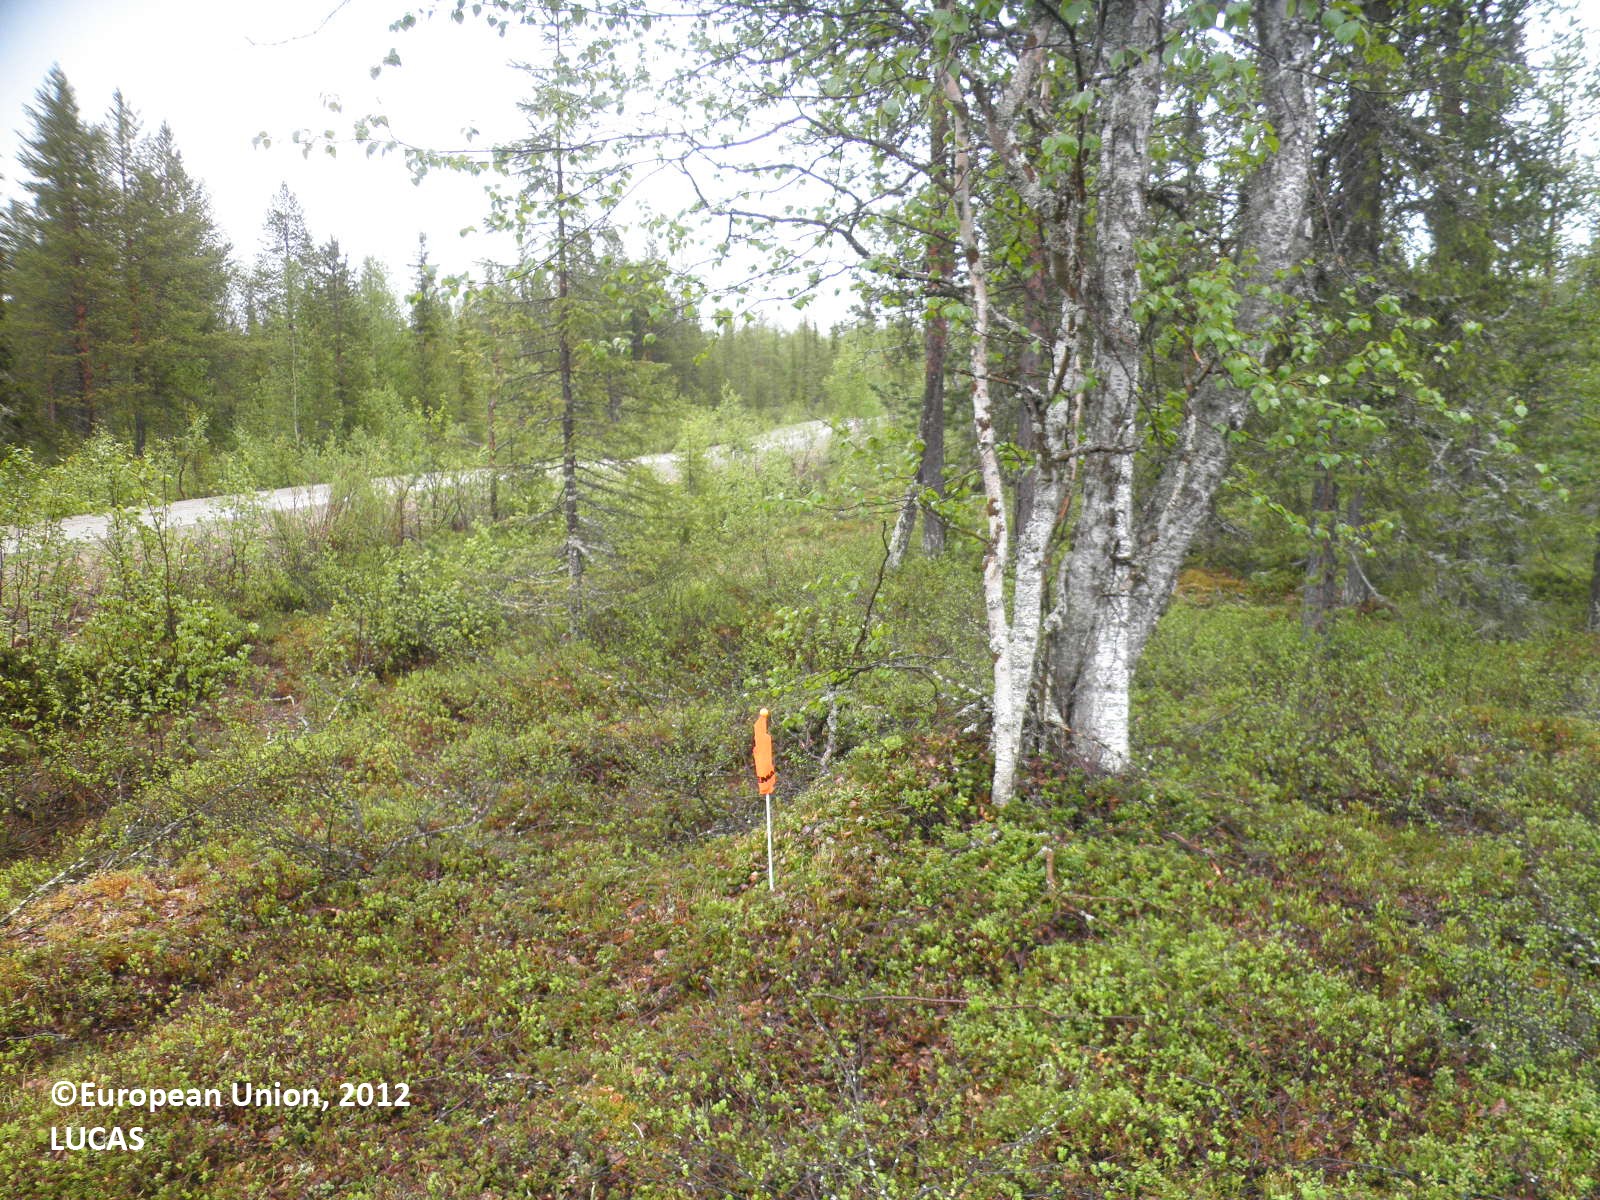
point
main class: Woodland
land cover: Pine dominated coniferous woodland
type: boreal forest
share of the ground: 50 - 75 %
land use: Forestry
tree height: > 5 m
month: June
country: FI
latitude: 67.9839
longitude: 25.5077
